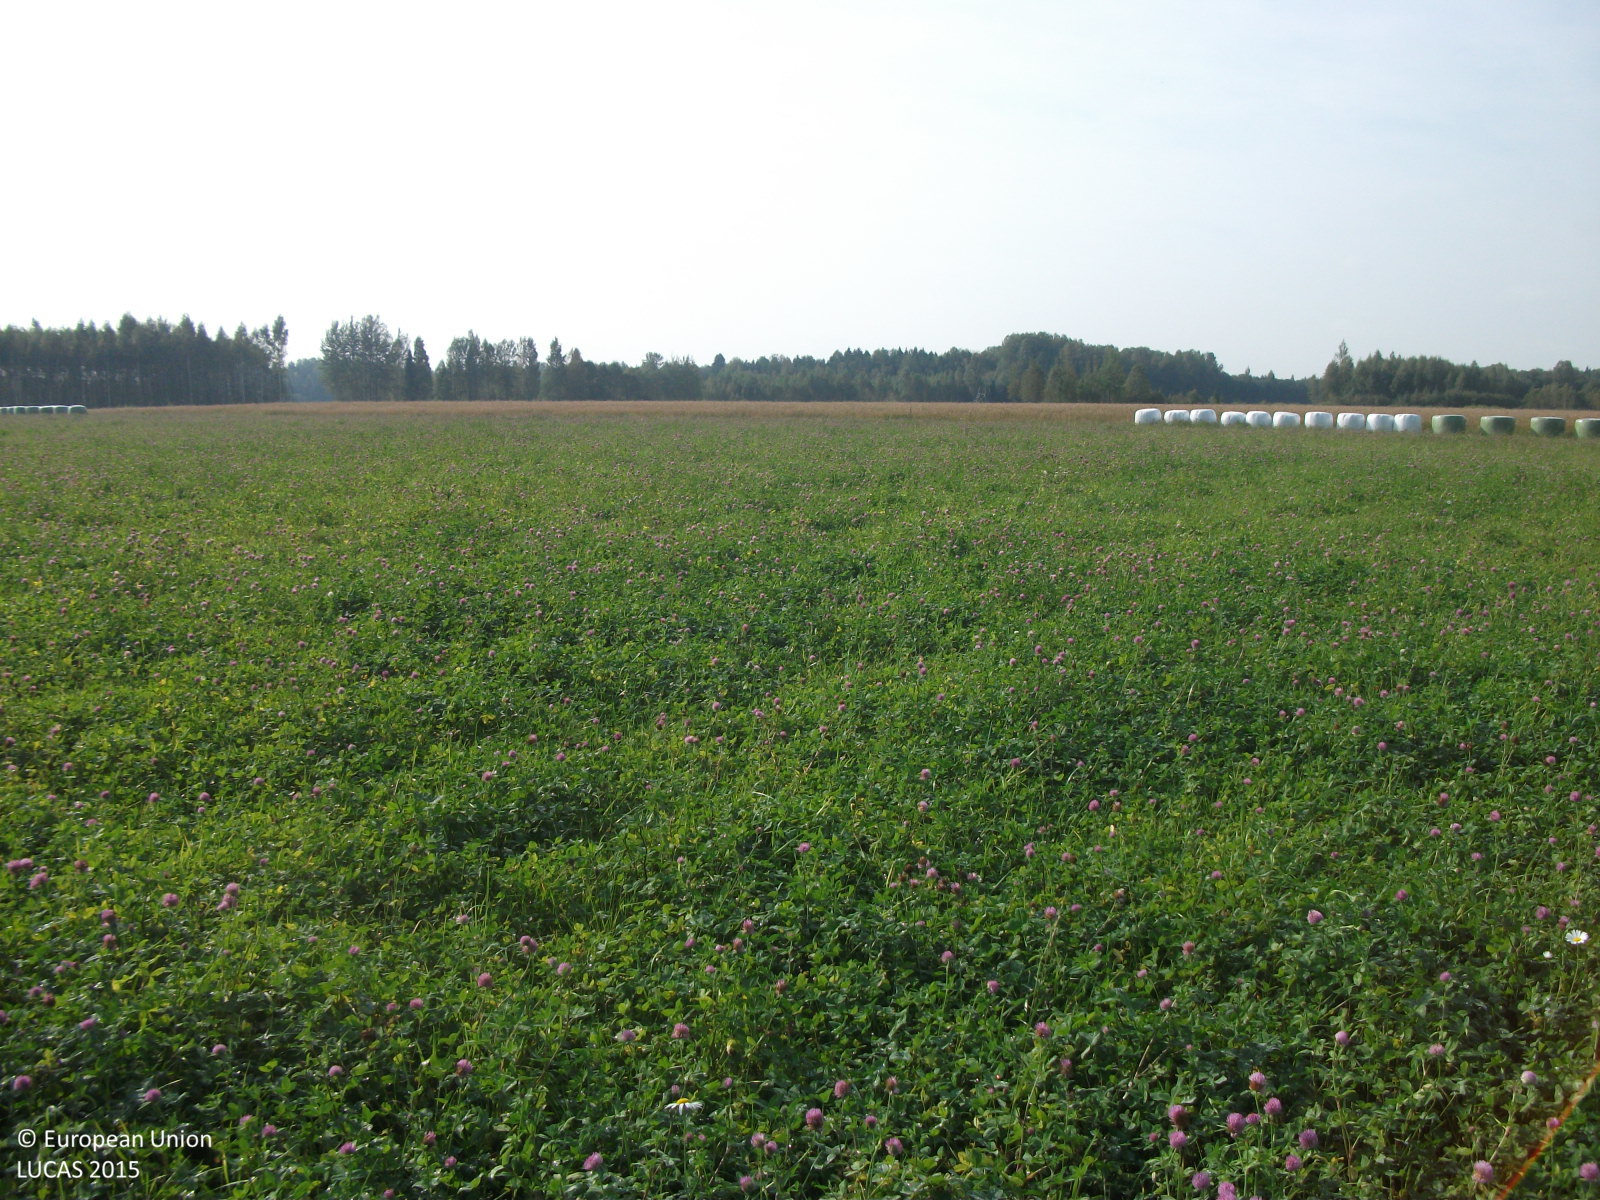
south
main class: Cropland
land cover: Clovers
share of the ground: > 75 %
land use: Agriculture (excluding fallow land and kitchen gardens)
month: September
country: LV
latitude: 57.9001
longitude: 24.8603
